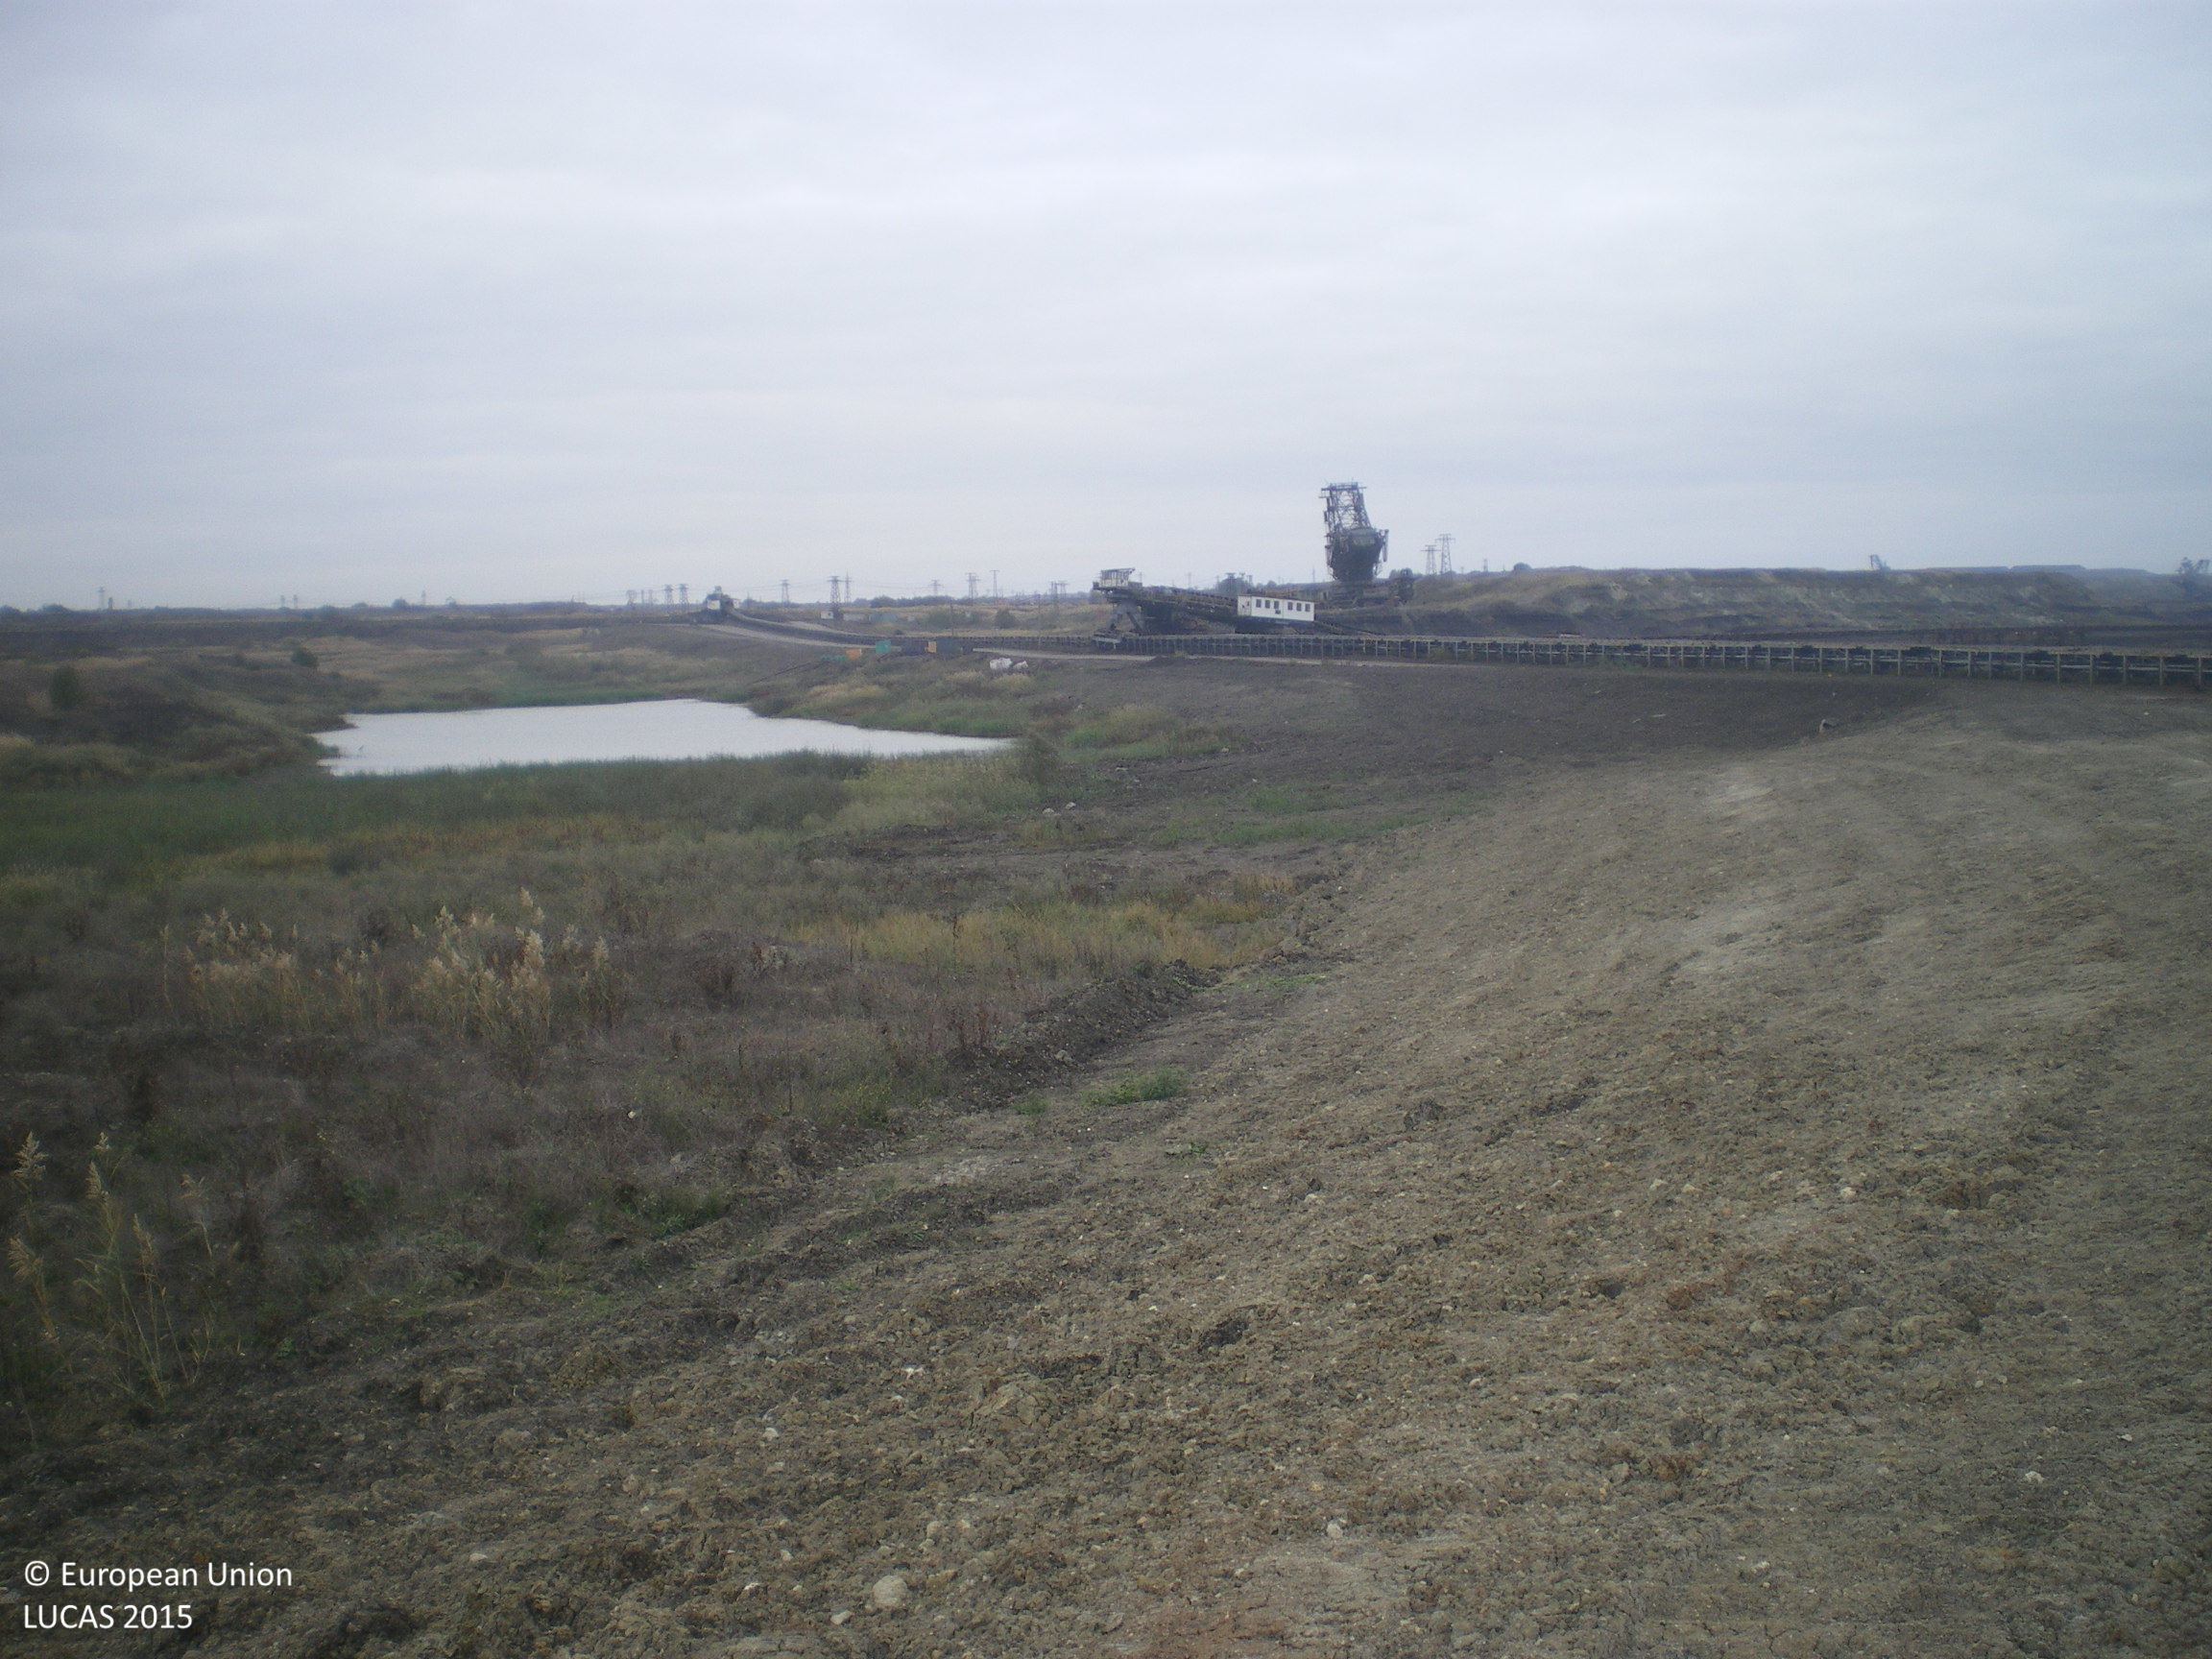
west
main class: Grassland
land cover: Grassland without tree/shrub cover
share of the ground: > 75 %
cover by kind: herbaceous plants 100 %
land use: Mining and quarrying
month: October
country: BG
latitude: 42.1989
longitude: 26.0025
